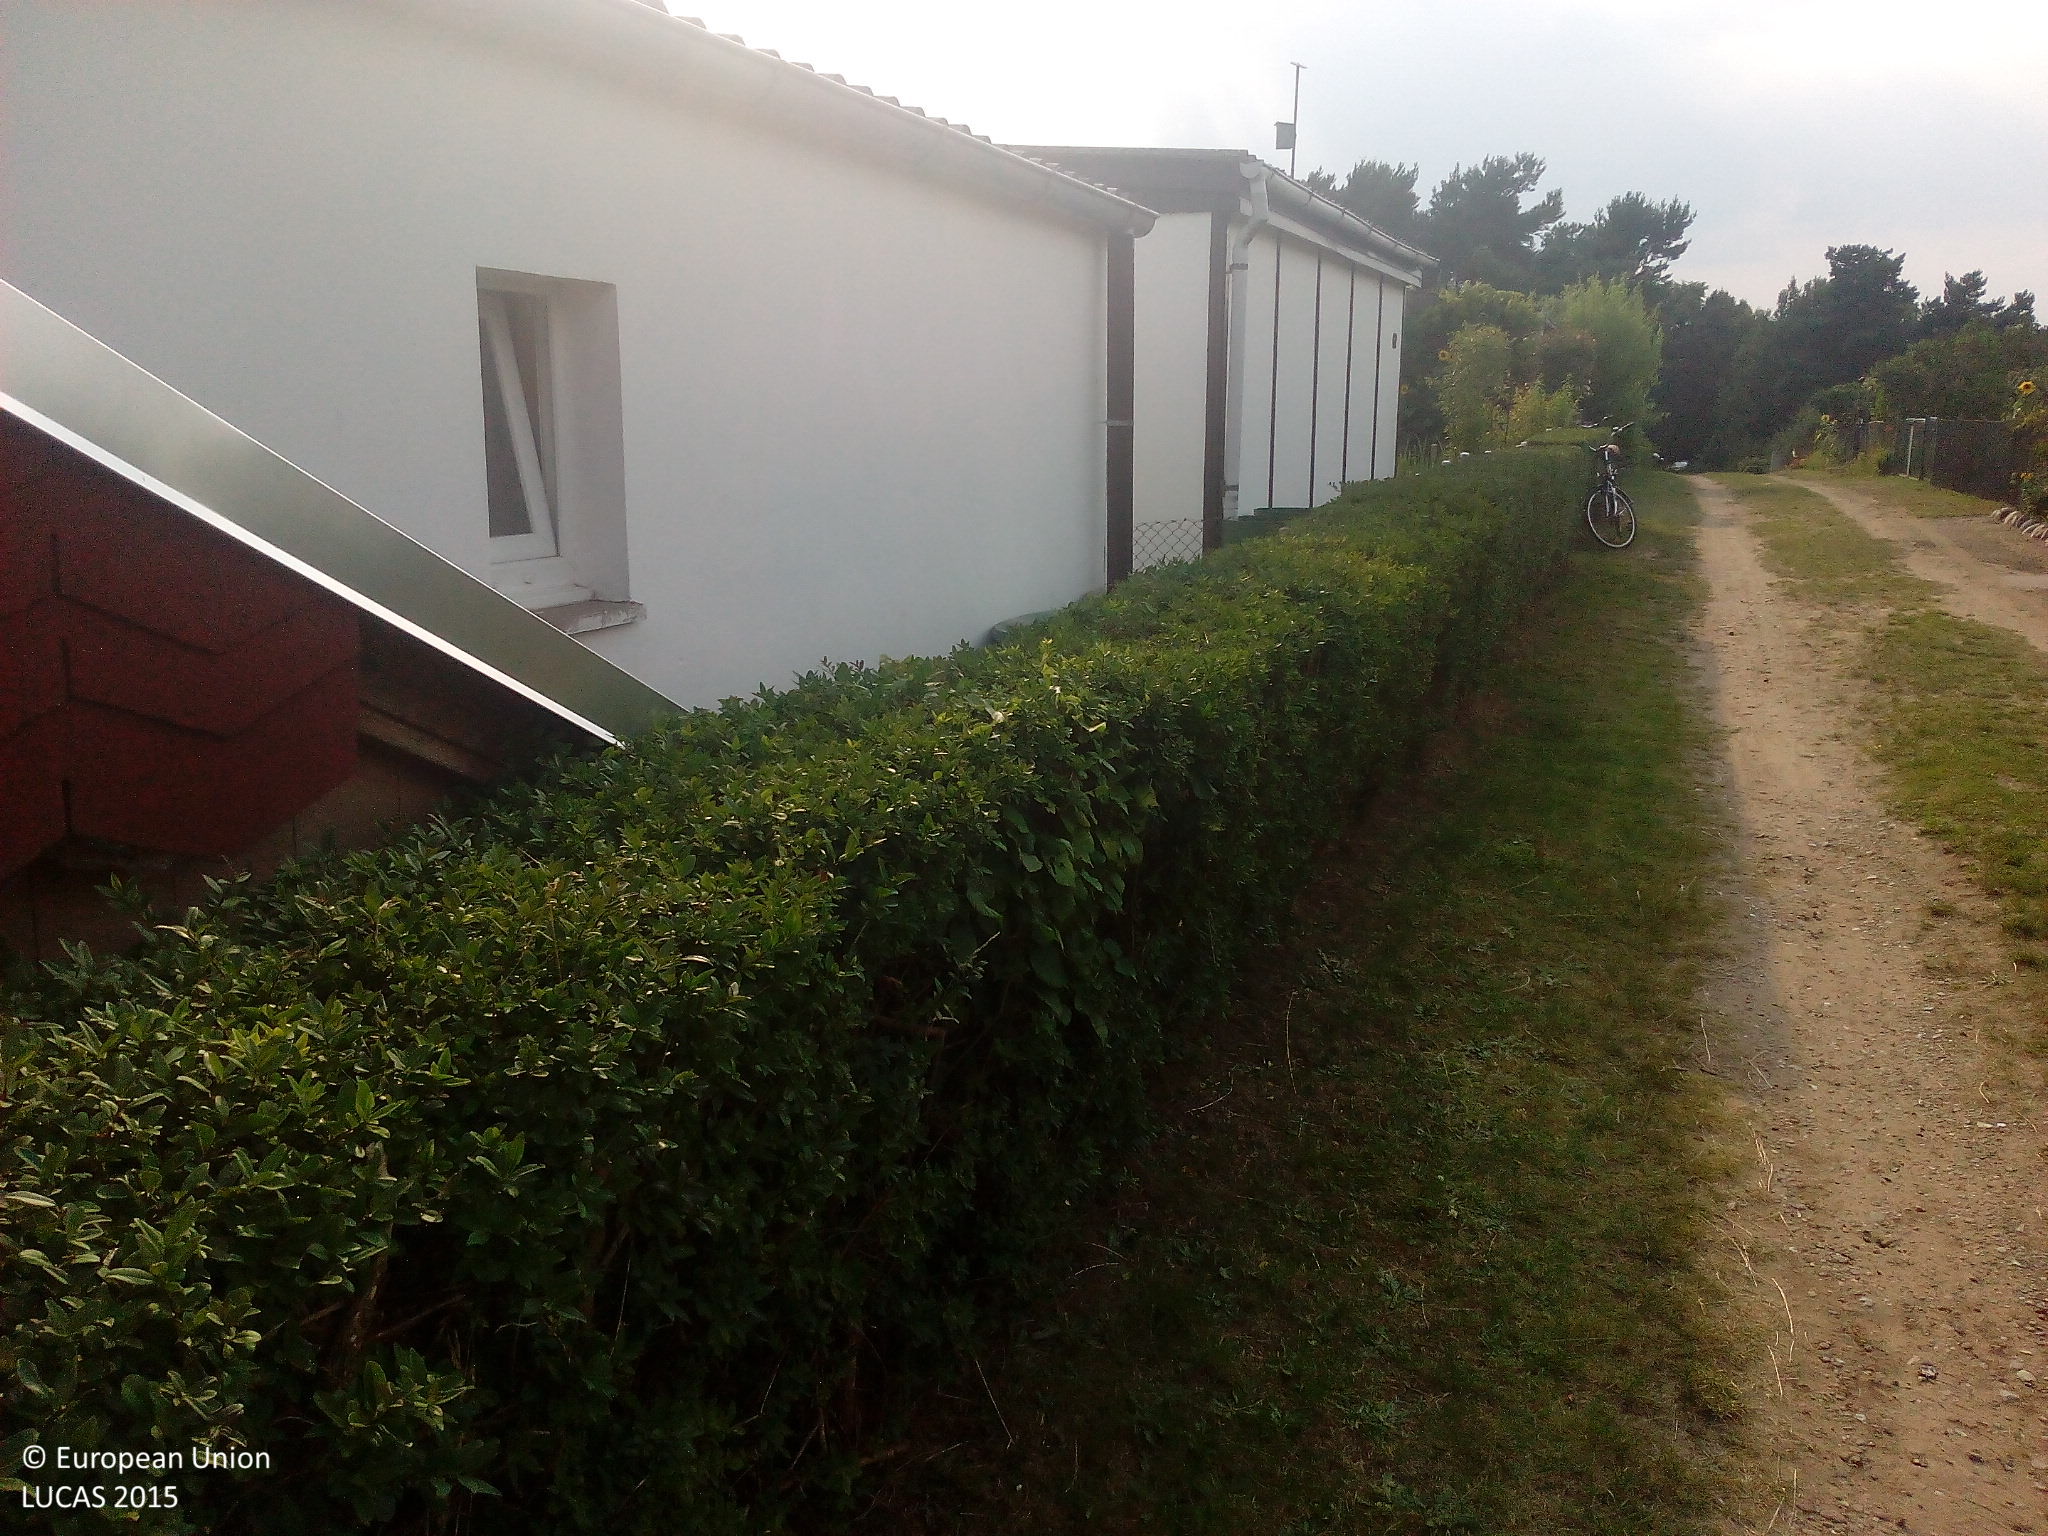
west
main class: Cropland
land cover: Other fresh vegetables
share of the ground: > 75 %
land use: Kitchen garden
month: August
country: DE
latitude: 53.5171
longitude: 12.6386
